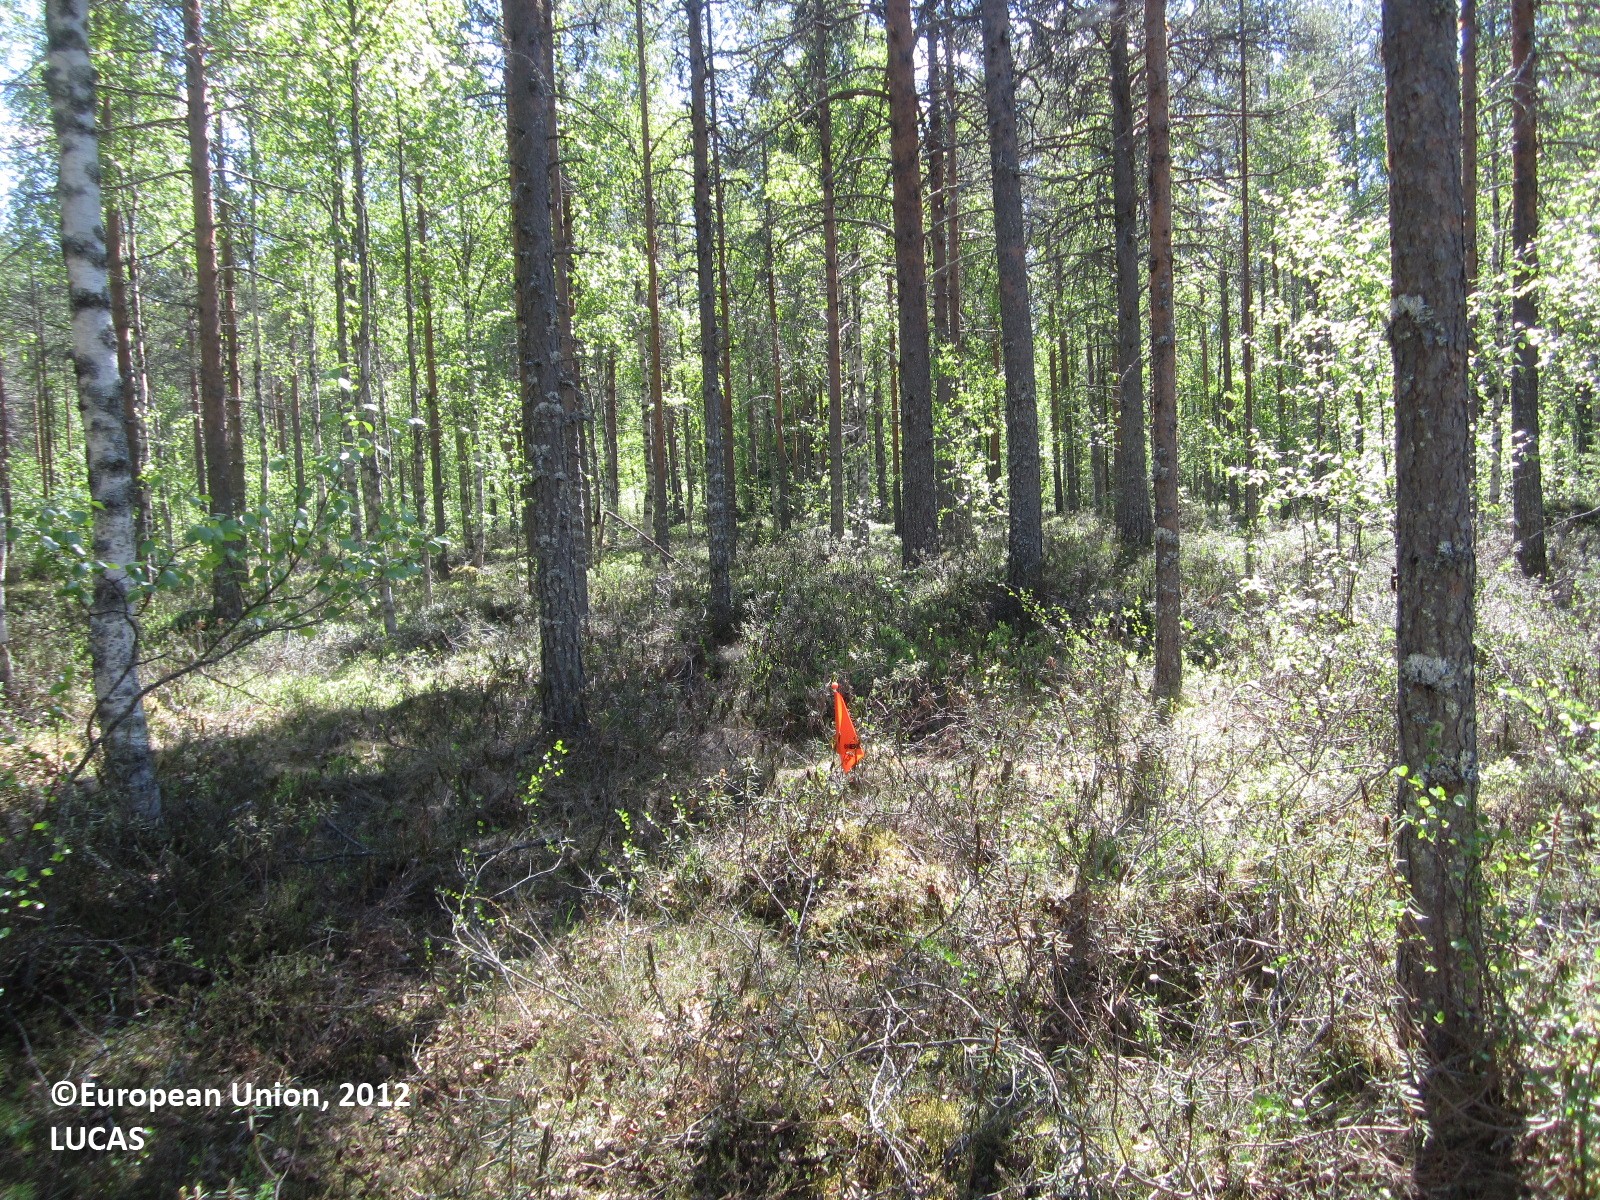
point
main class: Woodland
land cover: Pine dominated mixed woodland
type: boreal forest
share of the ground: 50 - 75 %
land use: Forestry
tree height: > 5 m
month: June
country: FI
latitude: 64.9034
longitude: 28.7967
